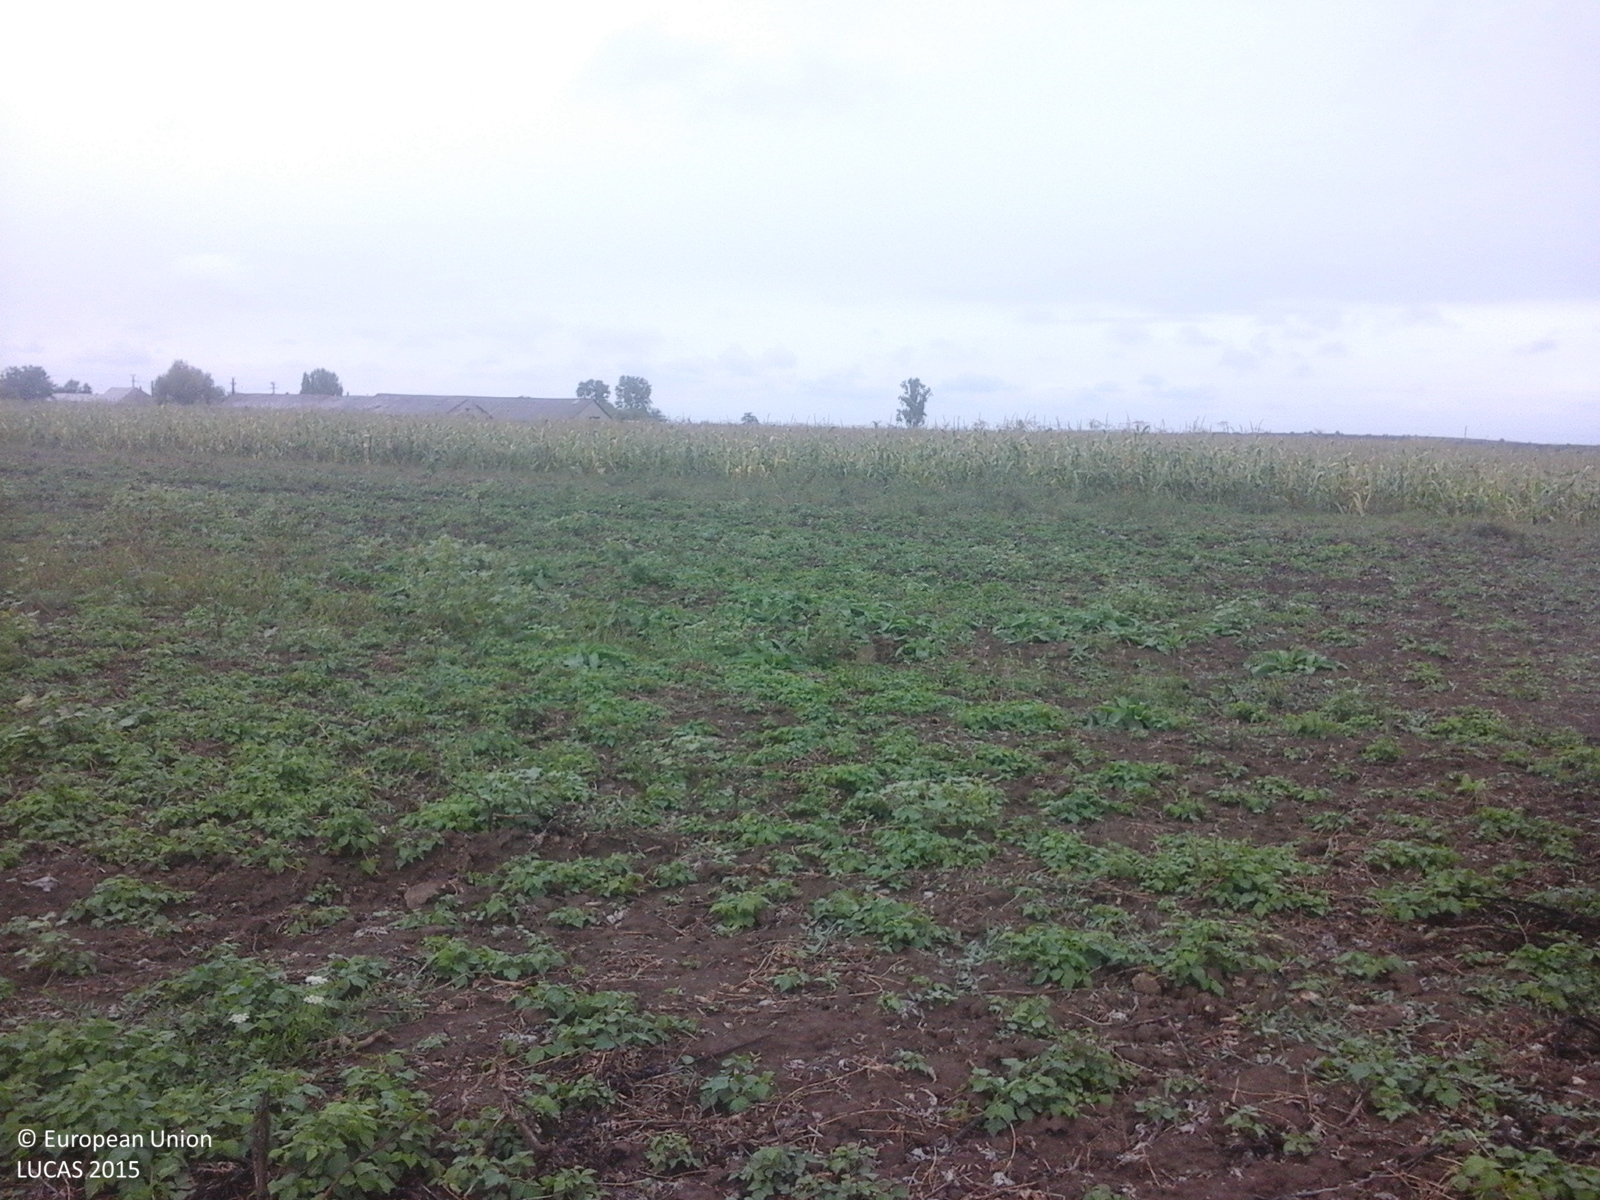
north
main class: Cropland
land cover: Maize
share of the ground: > 75 %
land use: Agriculture (excluding fallow land and kitchen gardens)
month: September
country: RO
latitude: 47.2198
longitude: 21.9989
